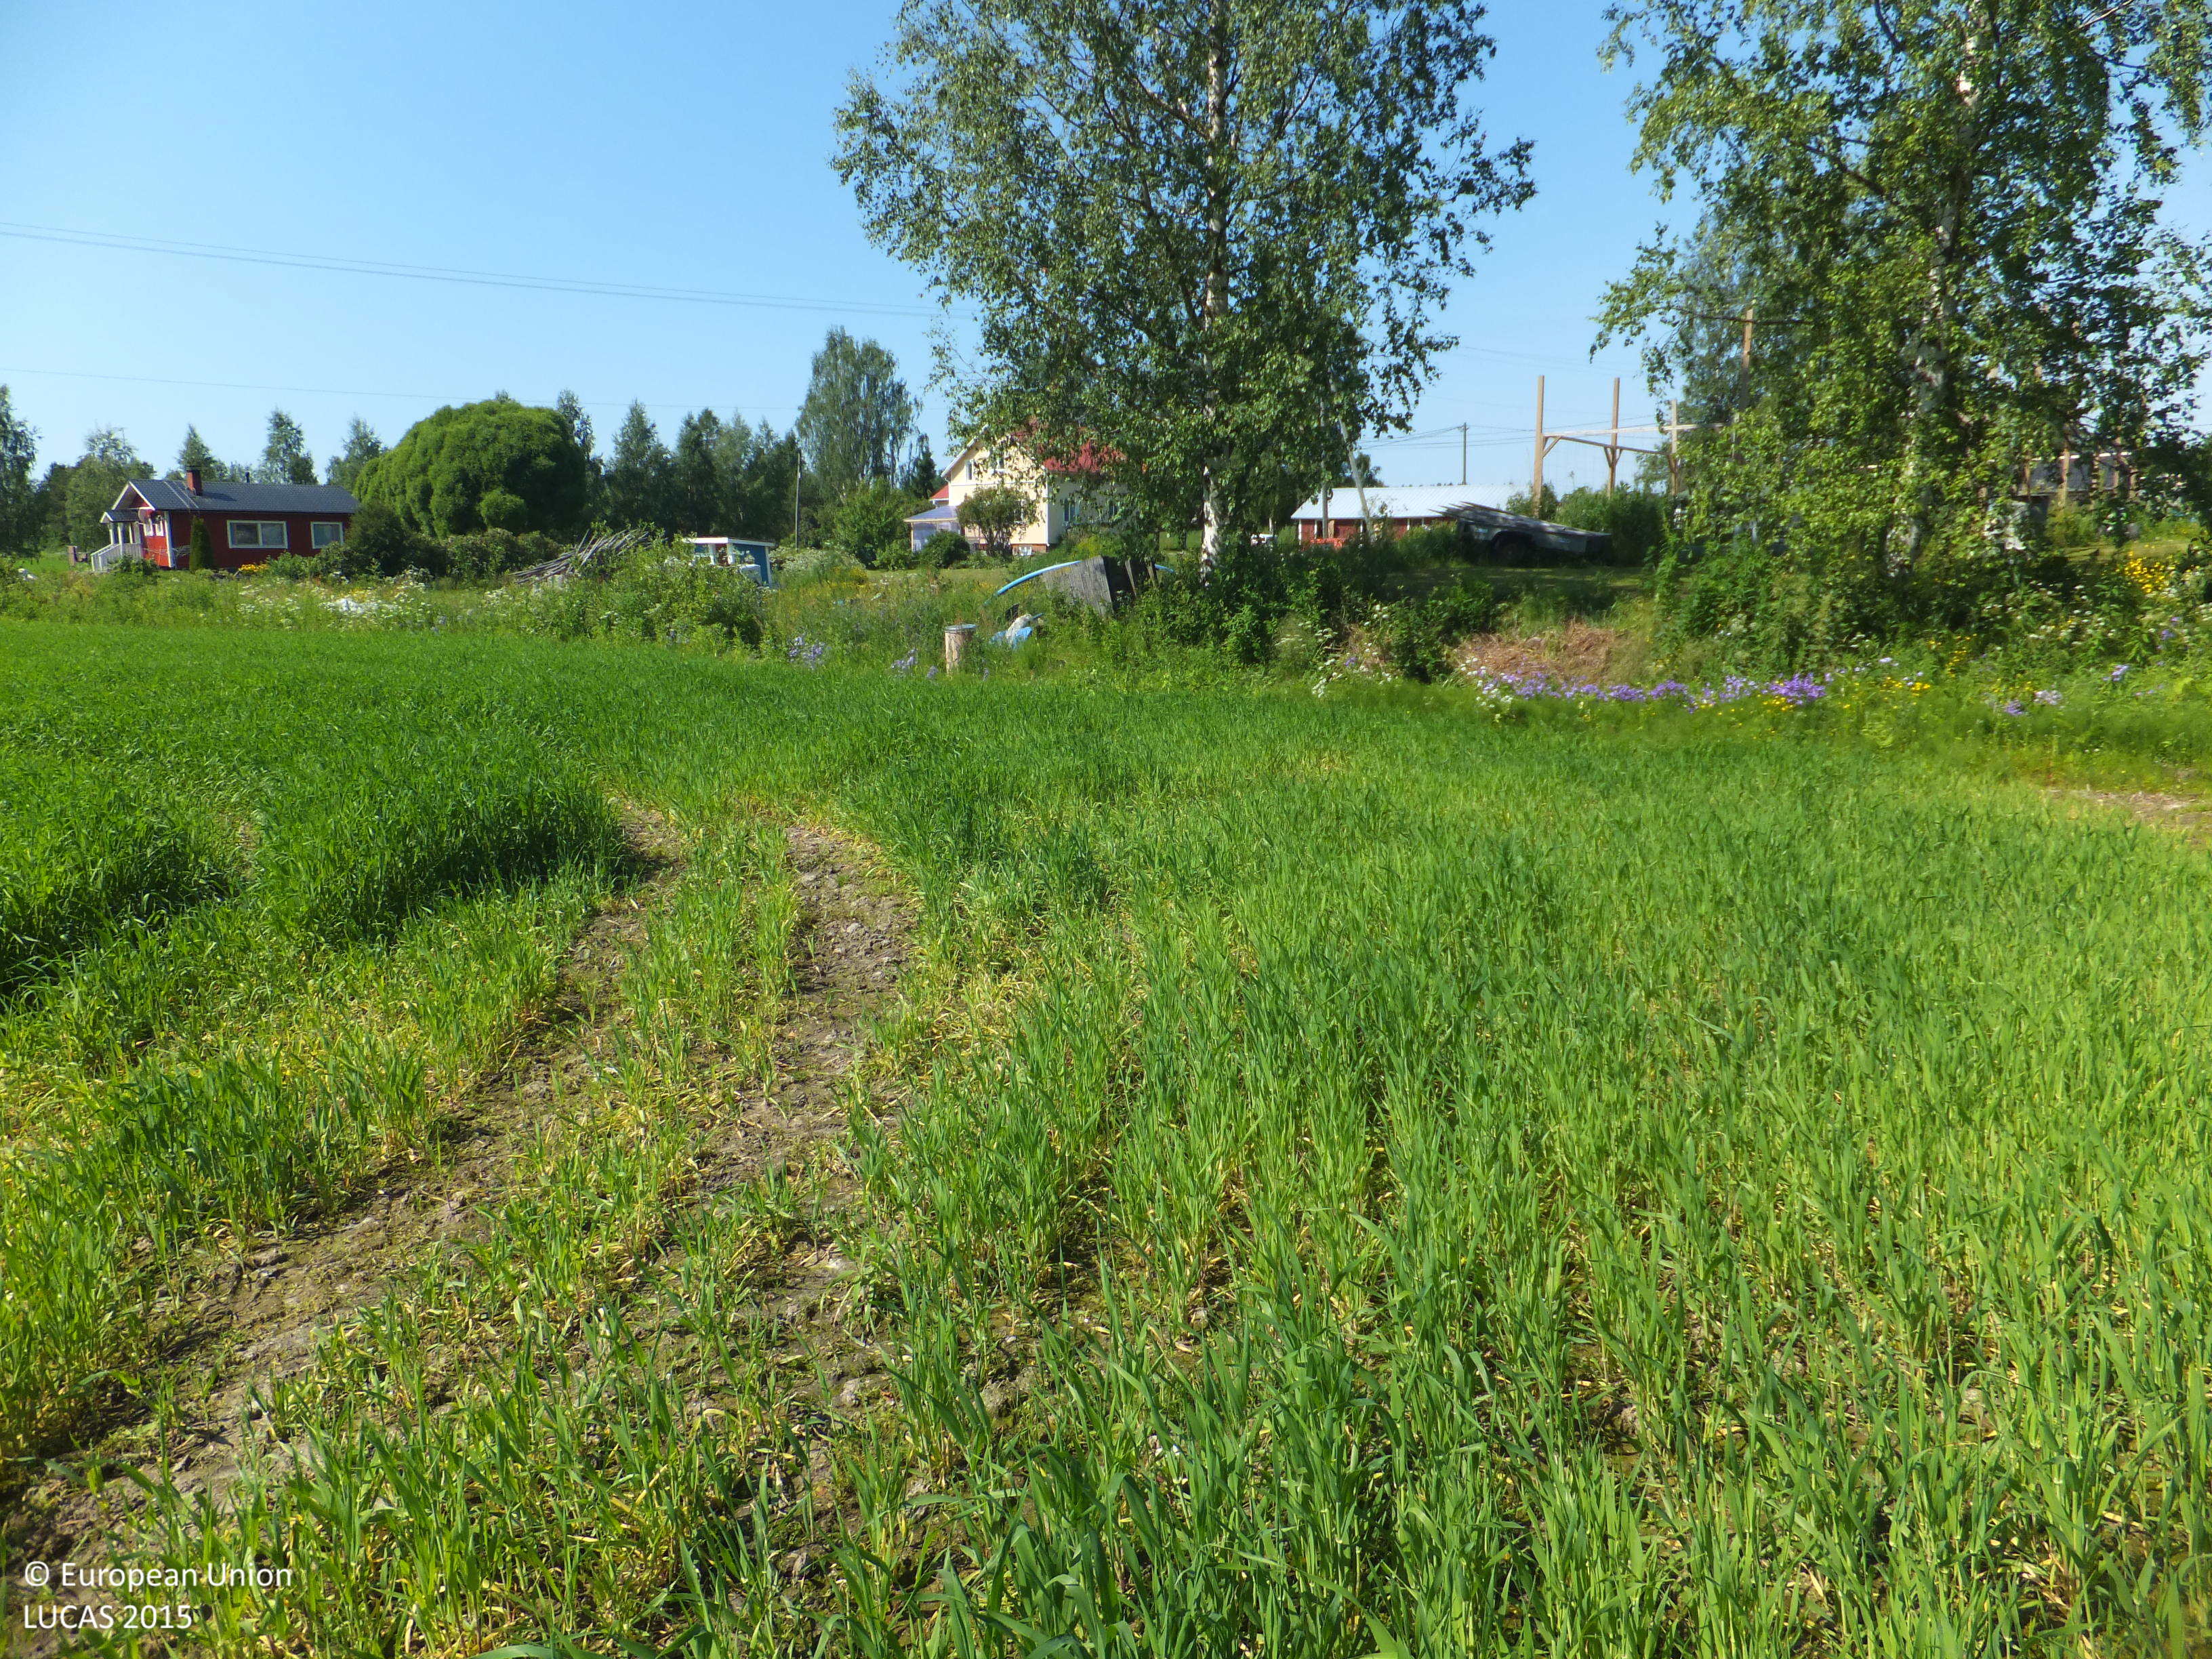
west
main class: Cropland
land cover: Barley
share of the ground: > 75 %
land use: Agriculture (excluding fallow land and kitchen gardens)
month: July
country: FI
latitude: 63.2272
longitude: 23.7388
